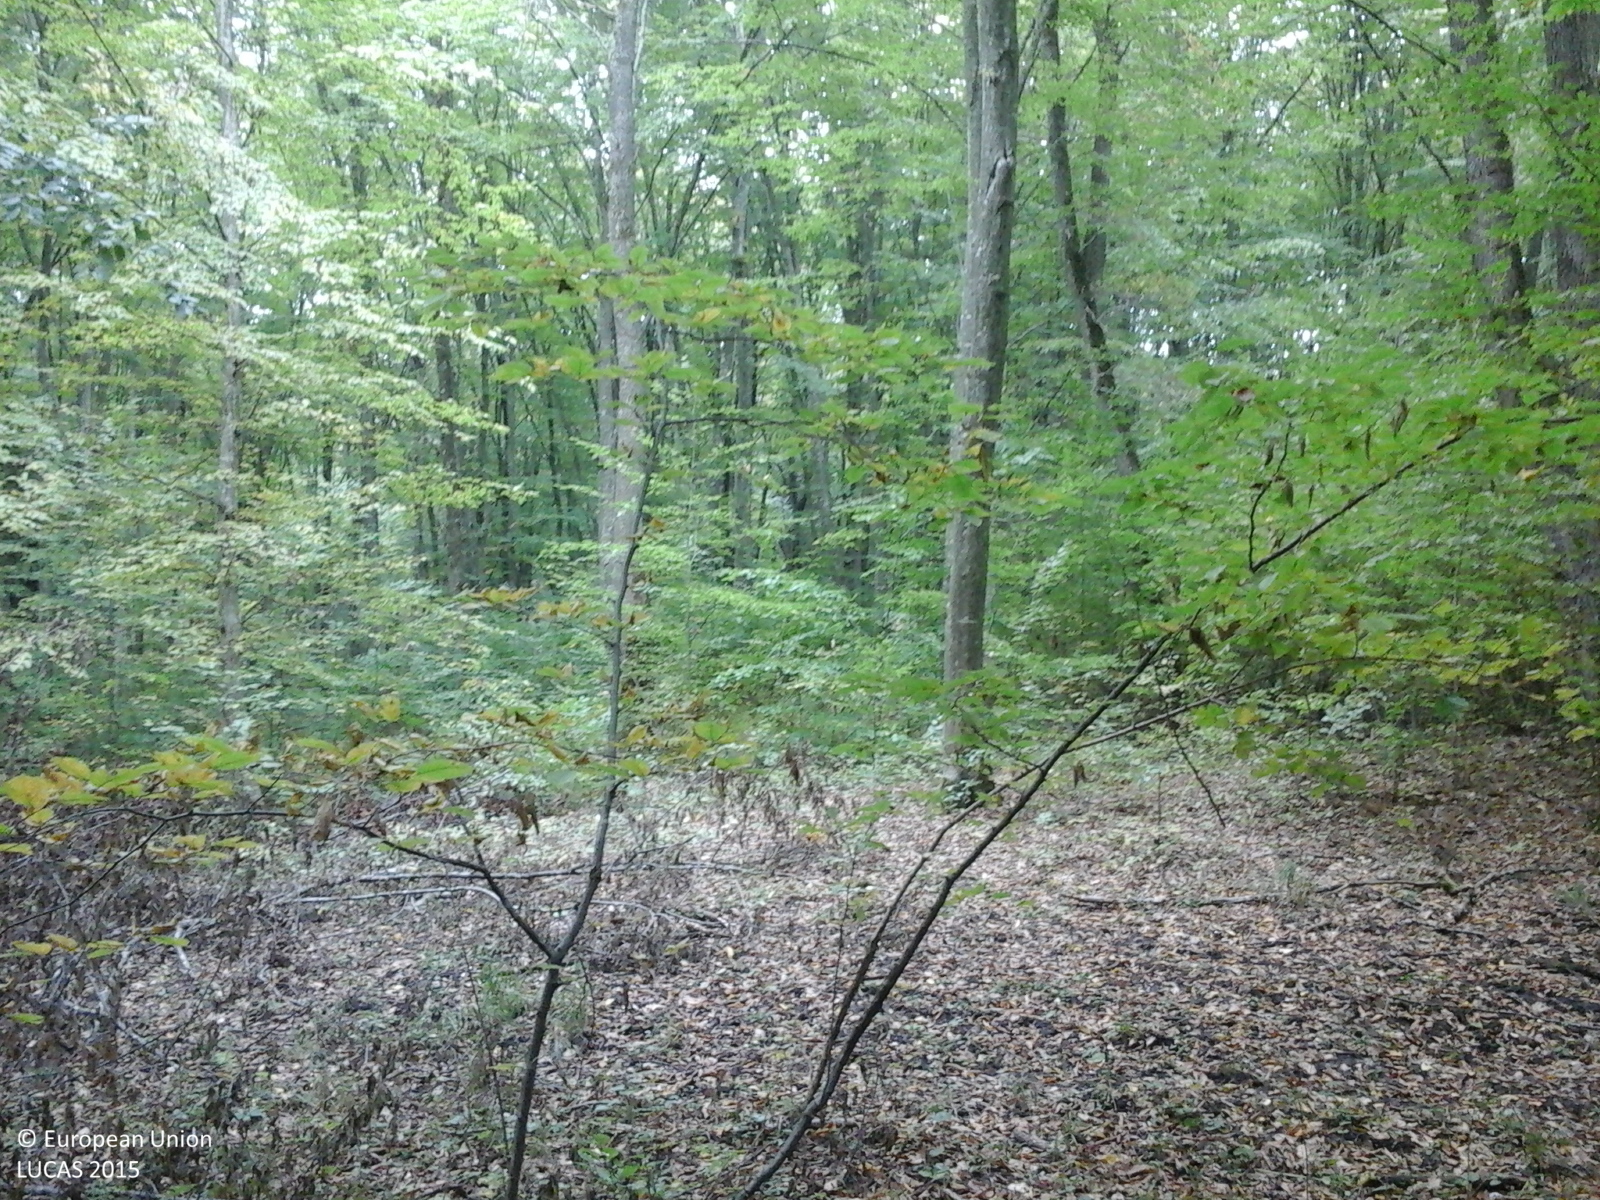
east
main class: Woodland
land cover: Broadleaved woodland
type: beech forest
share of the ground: > 75 %
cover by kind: broadleaved forest trees 100 %
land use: Forestry
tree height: > 5 m
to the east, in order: Broadleaved woodland; Ditches and canals; Broadleaved woodland
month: October
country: RO
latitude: 46.0429
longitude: 25.3371
